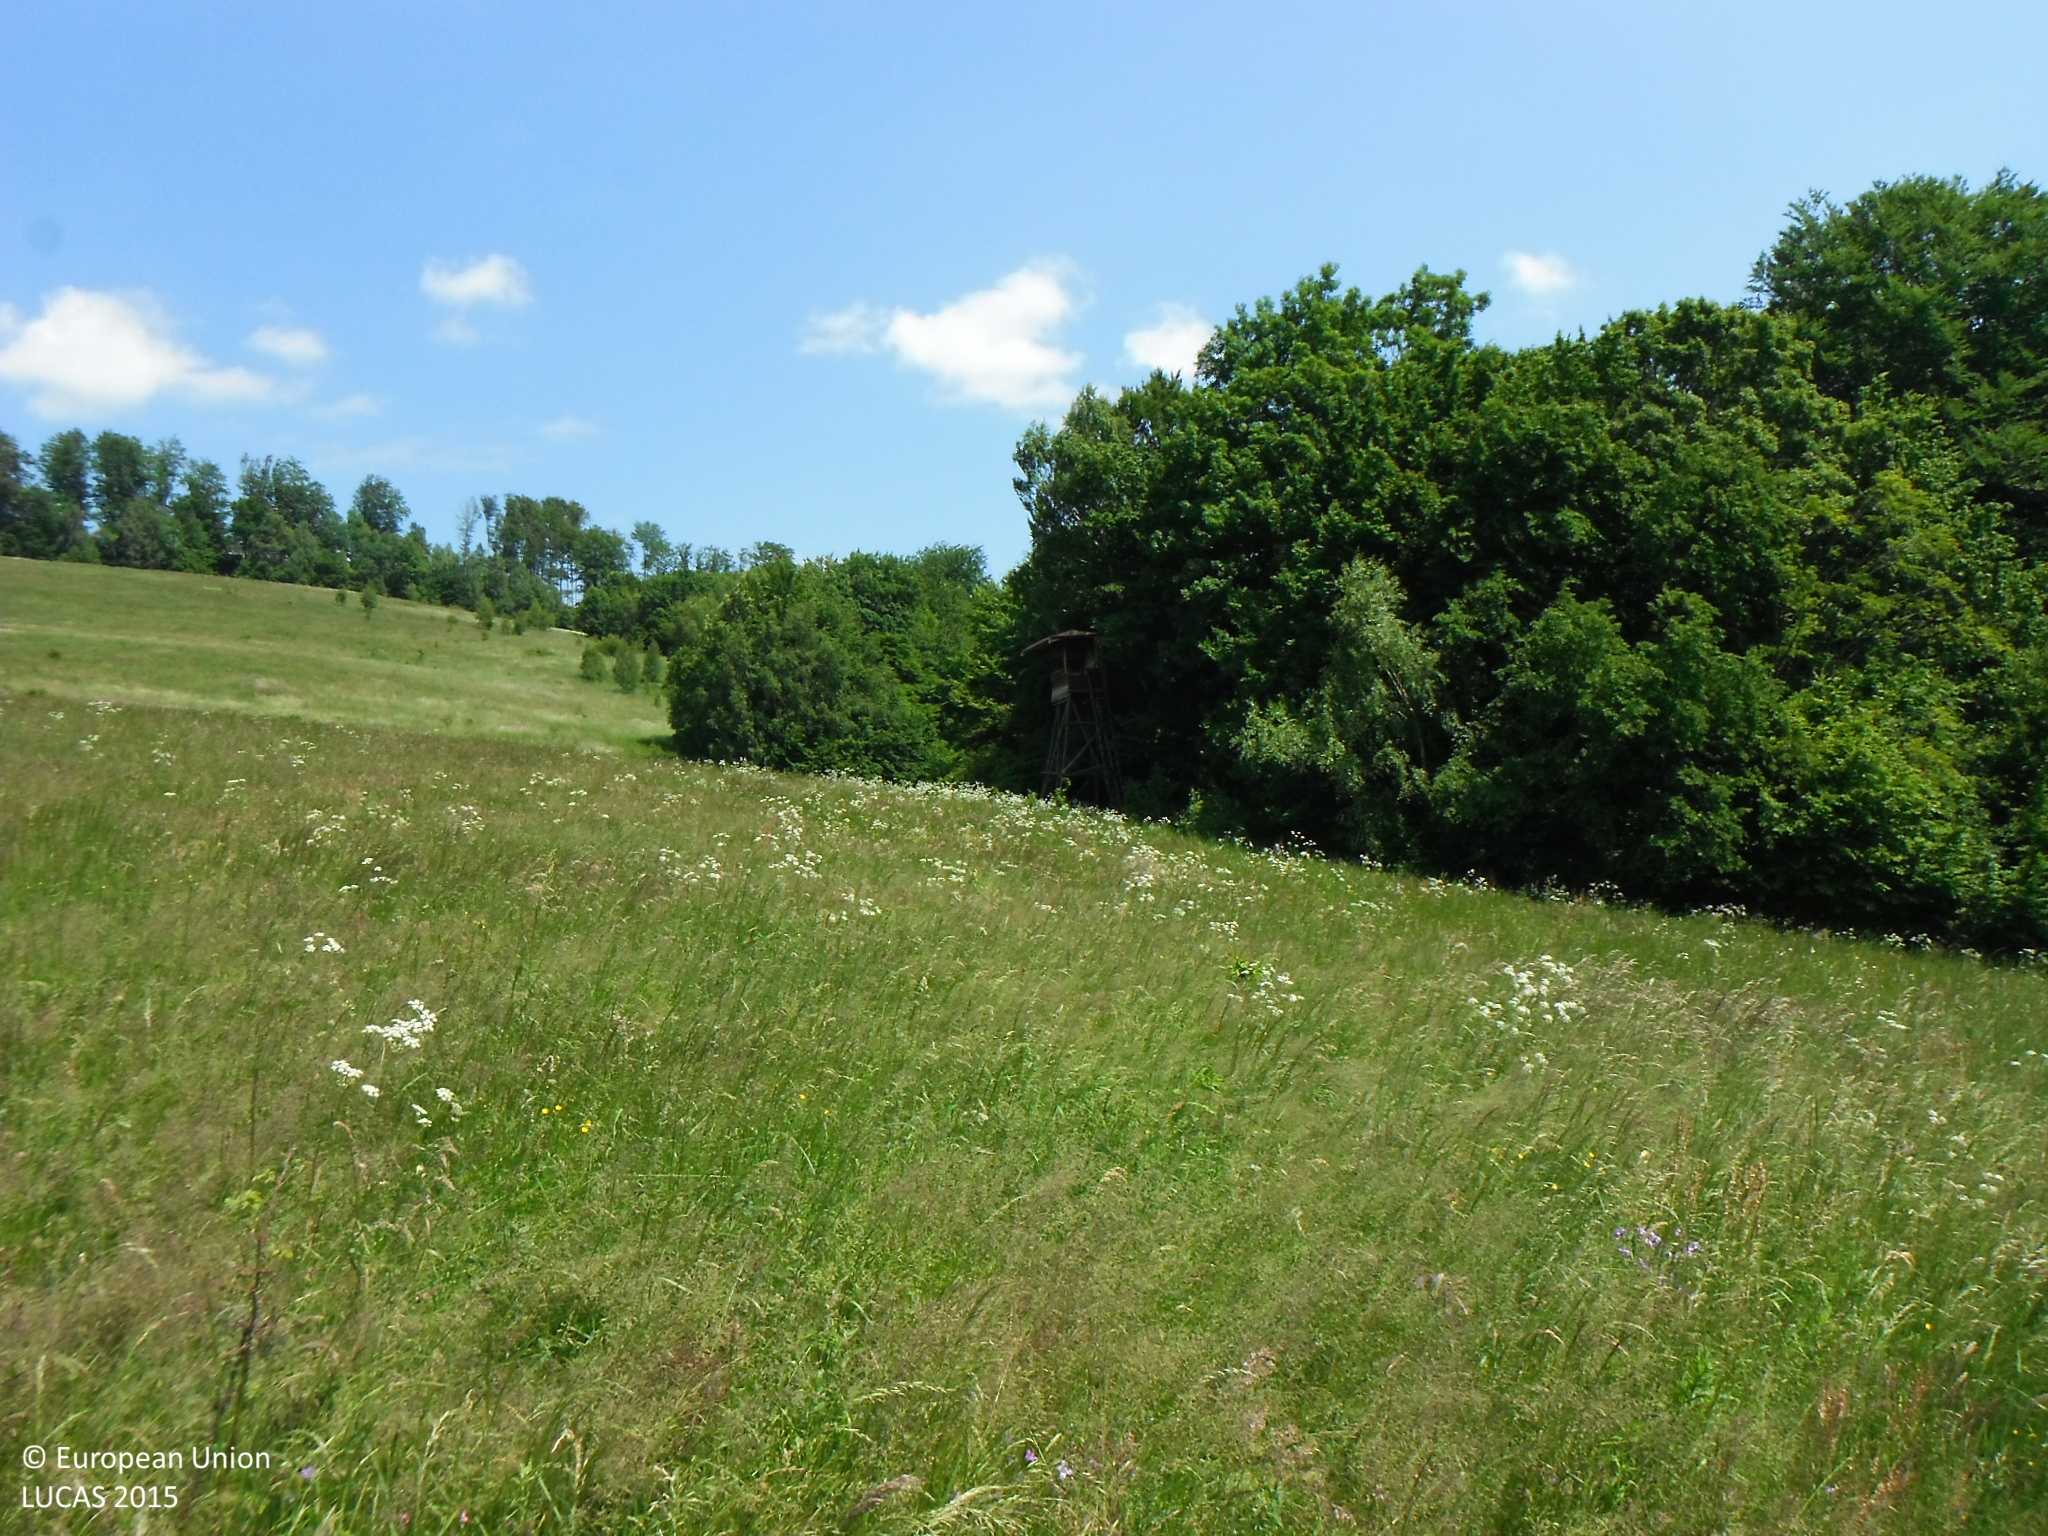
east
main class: Grassland
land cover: Grassland without tree/shrub cover
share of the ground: > 75 %
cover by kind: herbaceous plants 100 %
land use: Agriculture (excluding fallow land and kitchen gardens)
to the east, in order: Grassland without tree/shrub cover; Broadleaved woodland
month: June
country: SK
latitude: 48.7835
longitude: 21.1351
